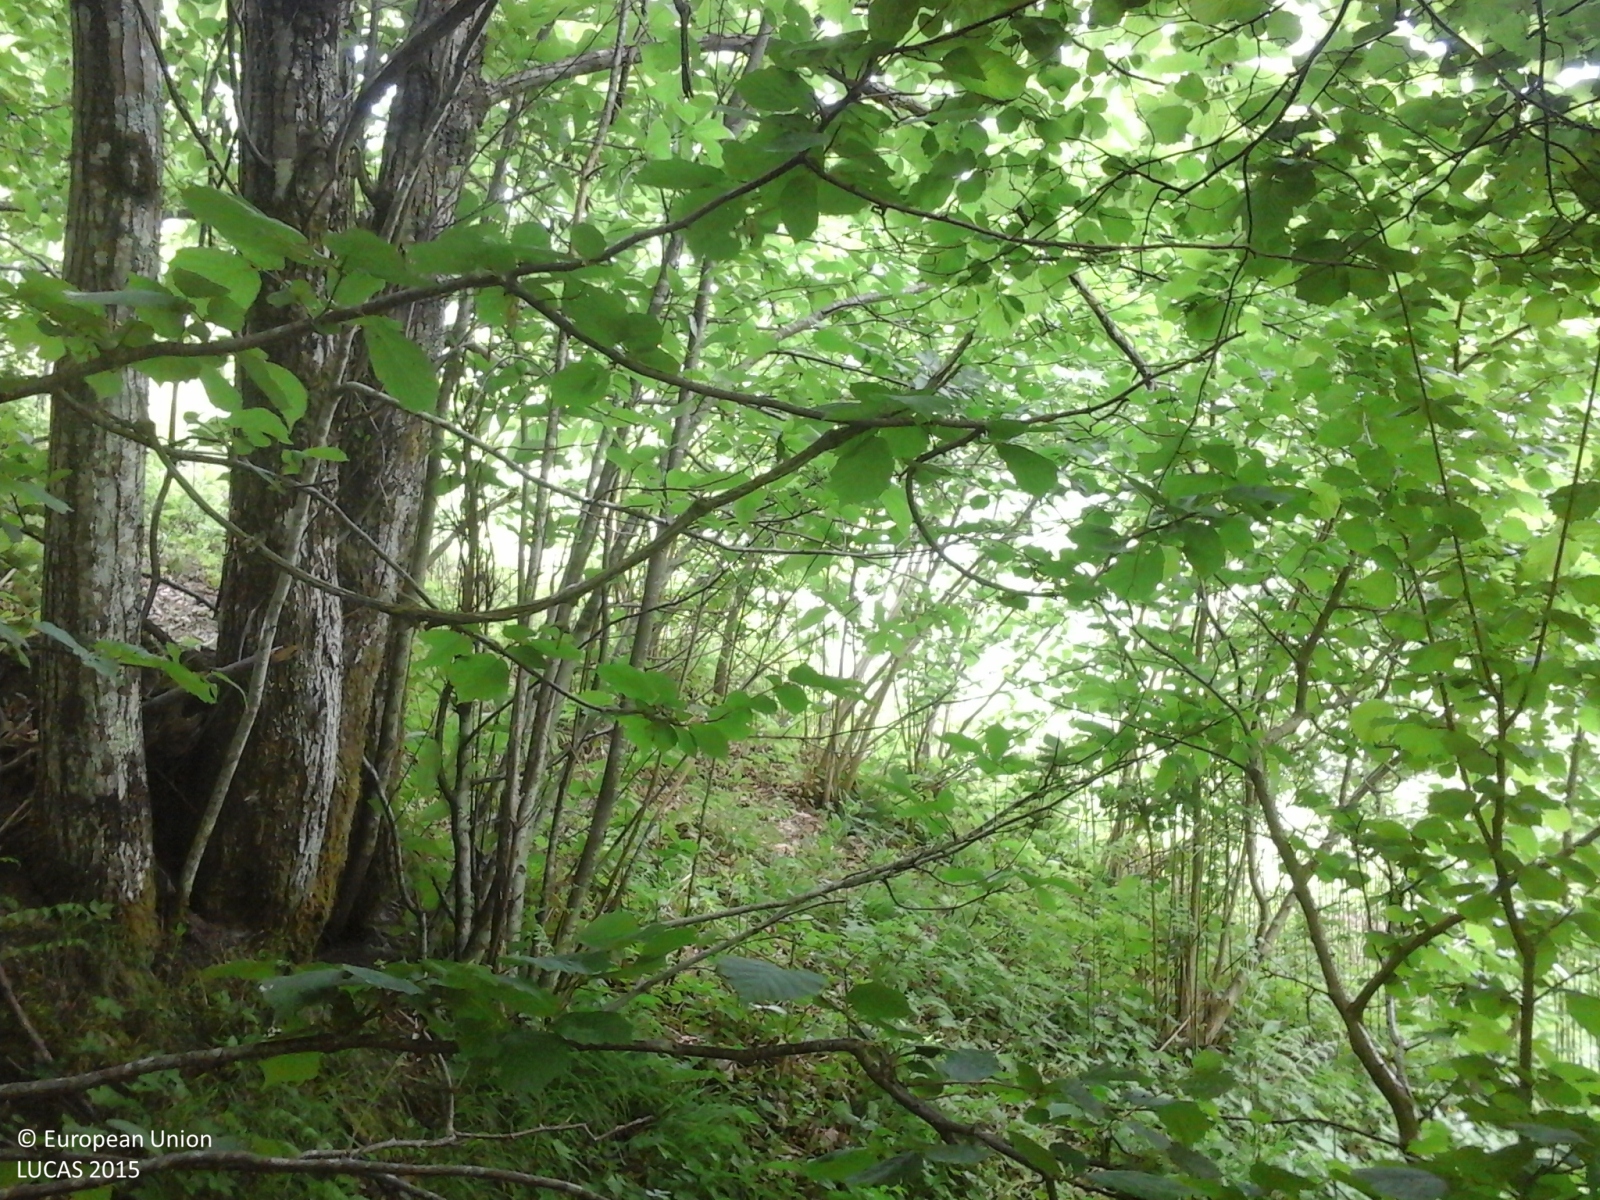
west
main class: Woodland
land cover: Broadleaved woodland
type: thermophilous deciduous forest
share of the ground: > 75 %
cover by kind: broadleaved forest trees 80 %, herbaceous plants 20 %
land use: Forestry
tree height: > 5 m
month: May
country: IT
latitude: 44.4222
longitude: 9.6867
